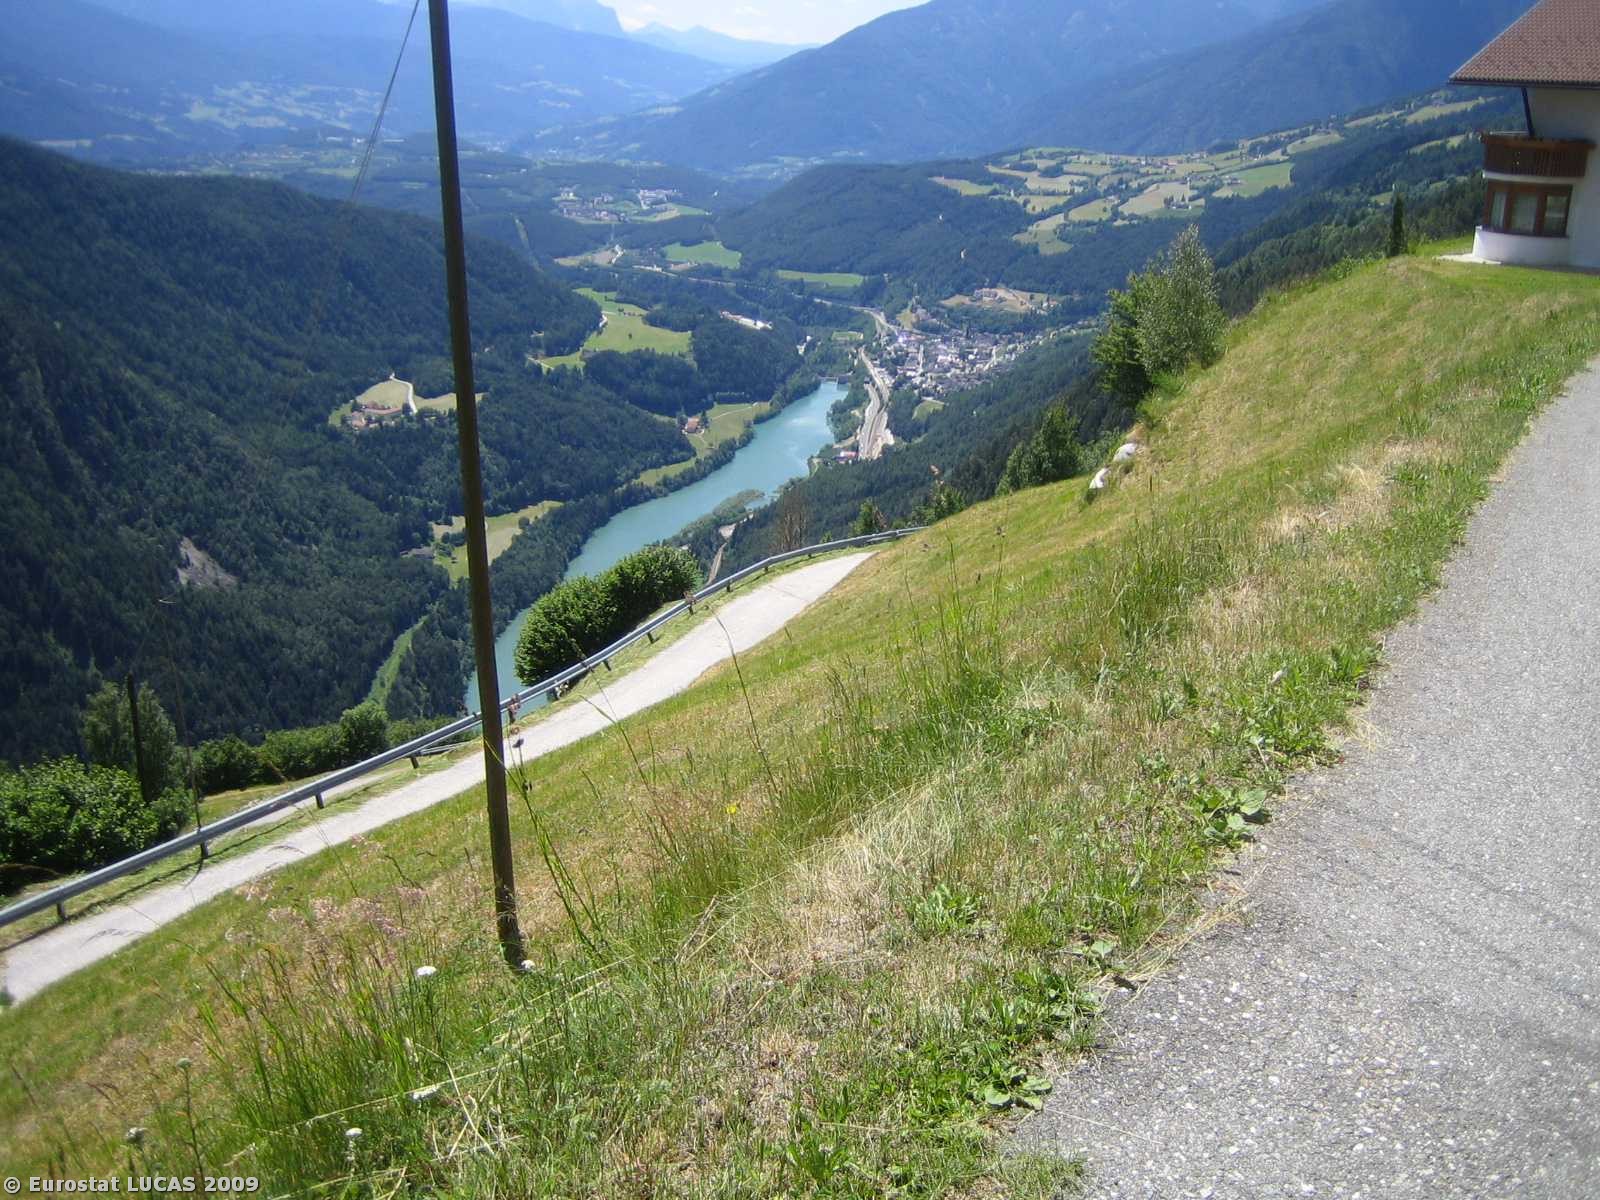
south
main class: Artificial land
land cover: Non built-up linear features
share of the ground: > 75 %
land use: Road transport
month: June
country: IT
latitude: 46.8242
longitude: 11.6892
